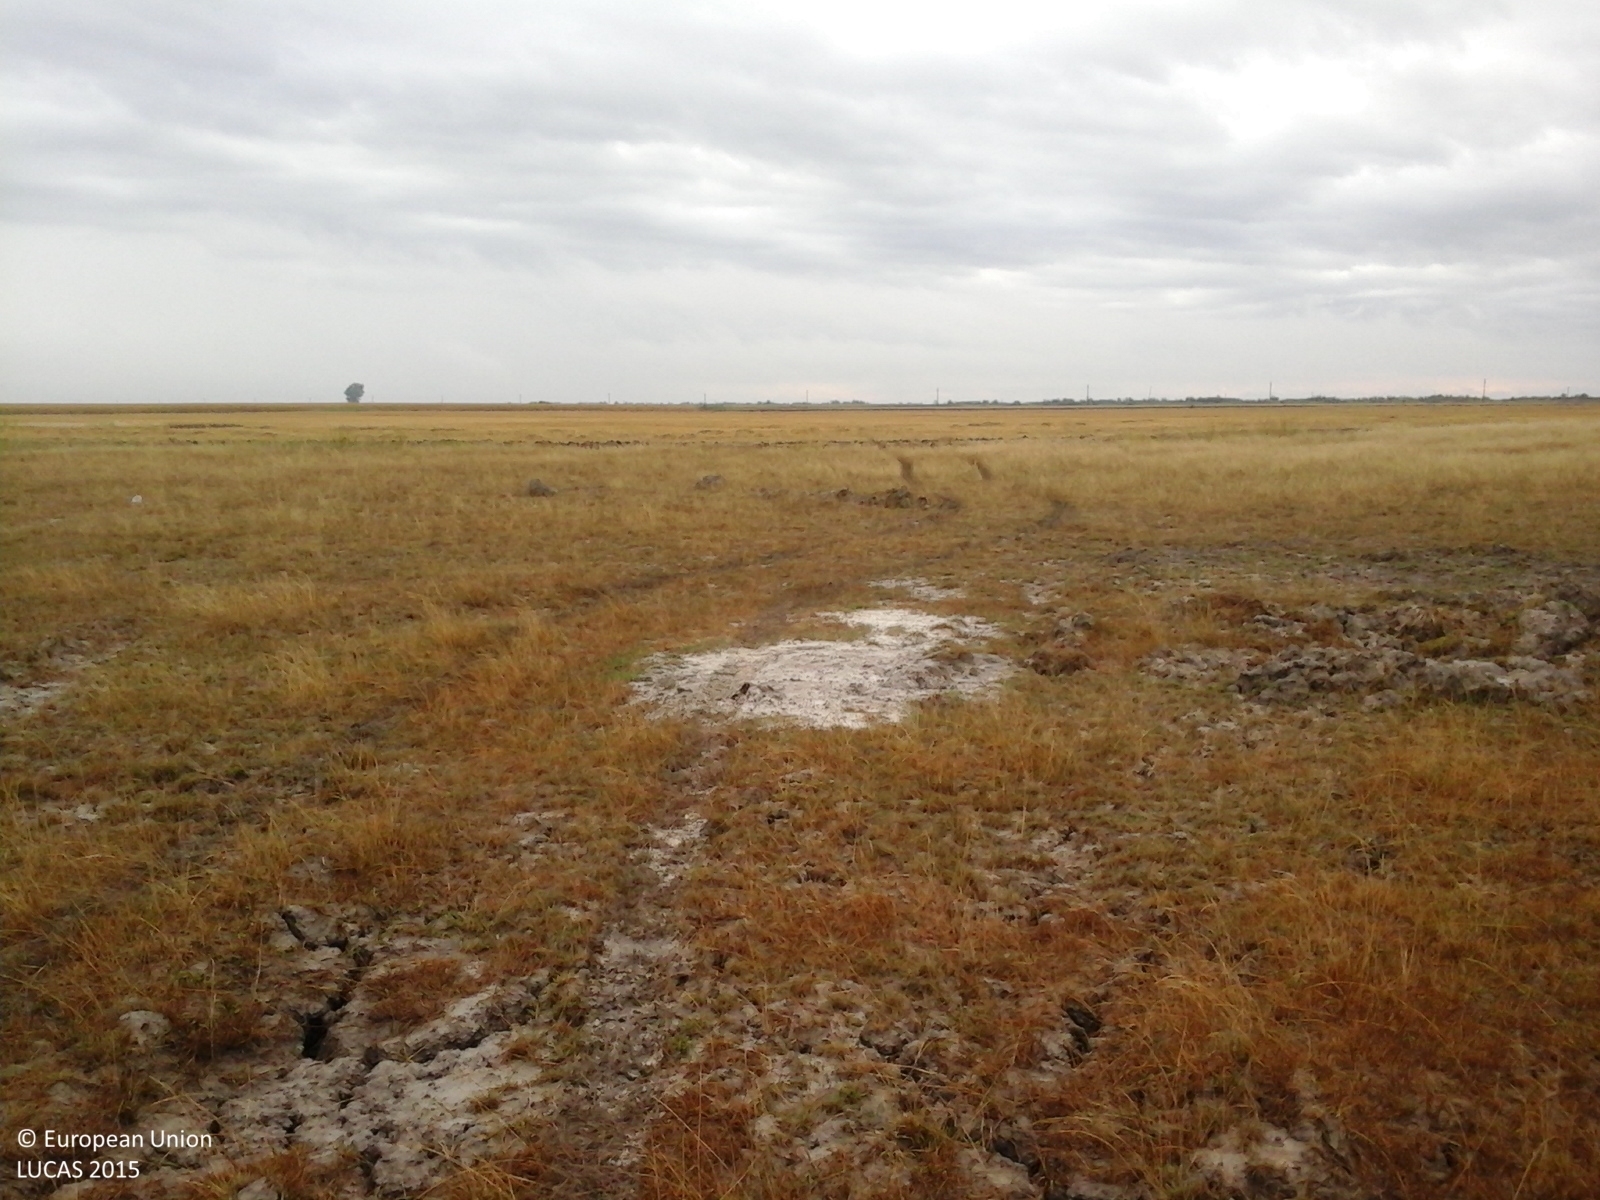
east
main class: Grassland
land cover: Grassland without tree/shrub cover
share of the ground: > 75 %
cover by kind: herbaceous plants 100 %
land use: Agriculture (excluding fallow land and kitchen gardens)
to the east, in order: Grassland without tree/shrub cover; Common wheat
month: August
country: RO
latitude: 45.5811
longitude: 21.0105
